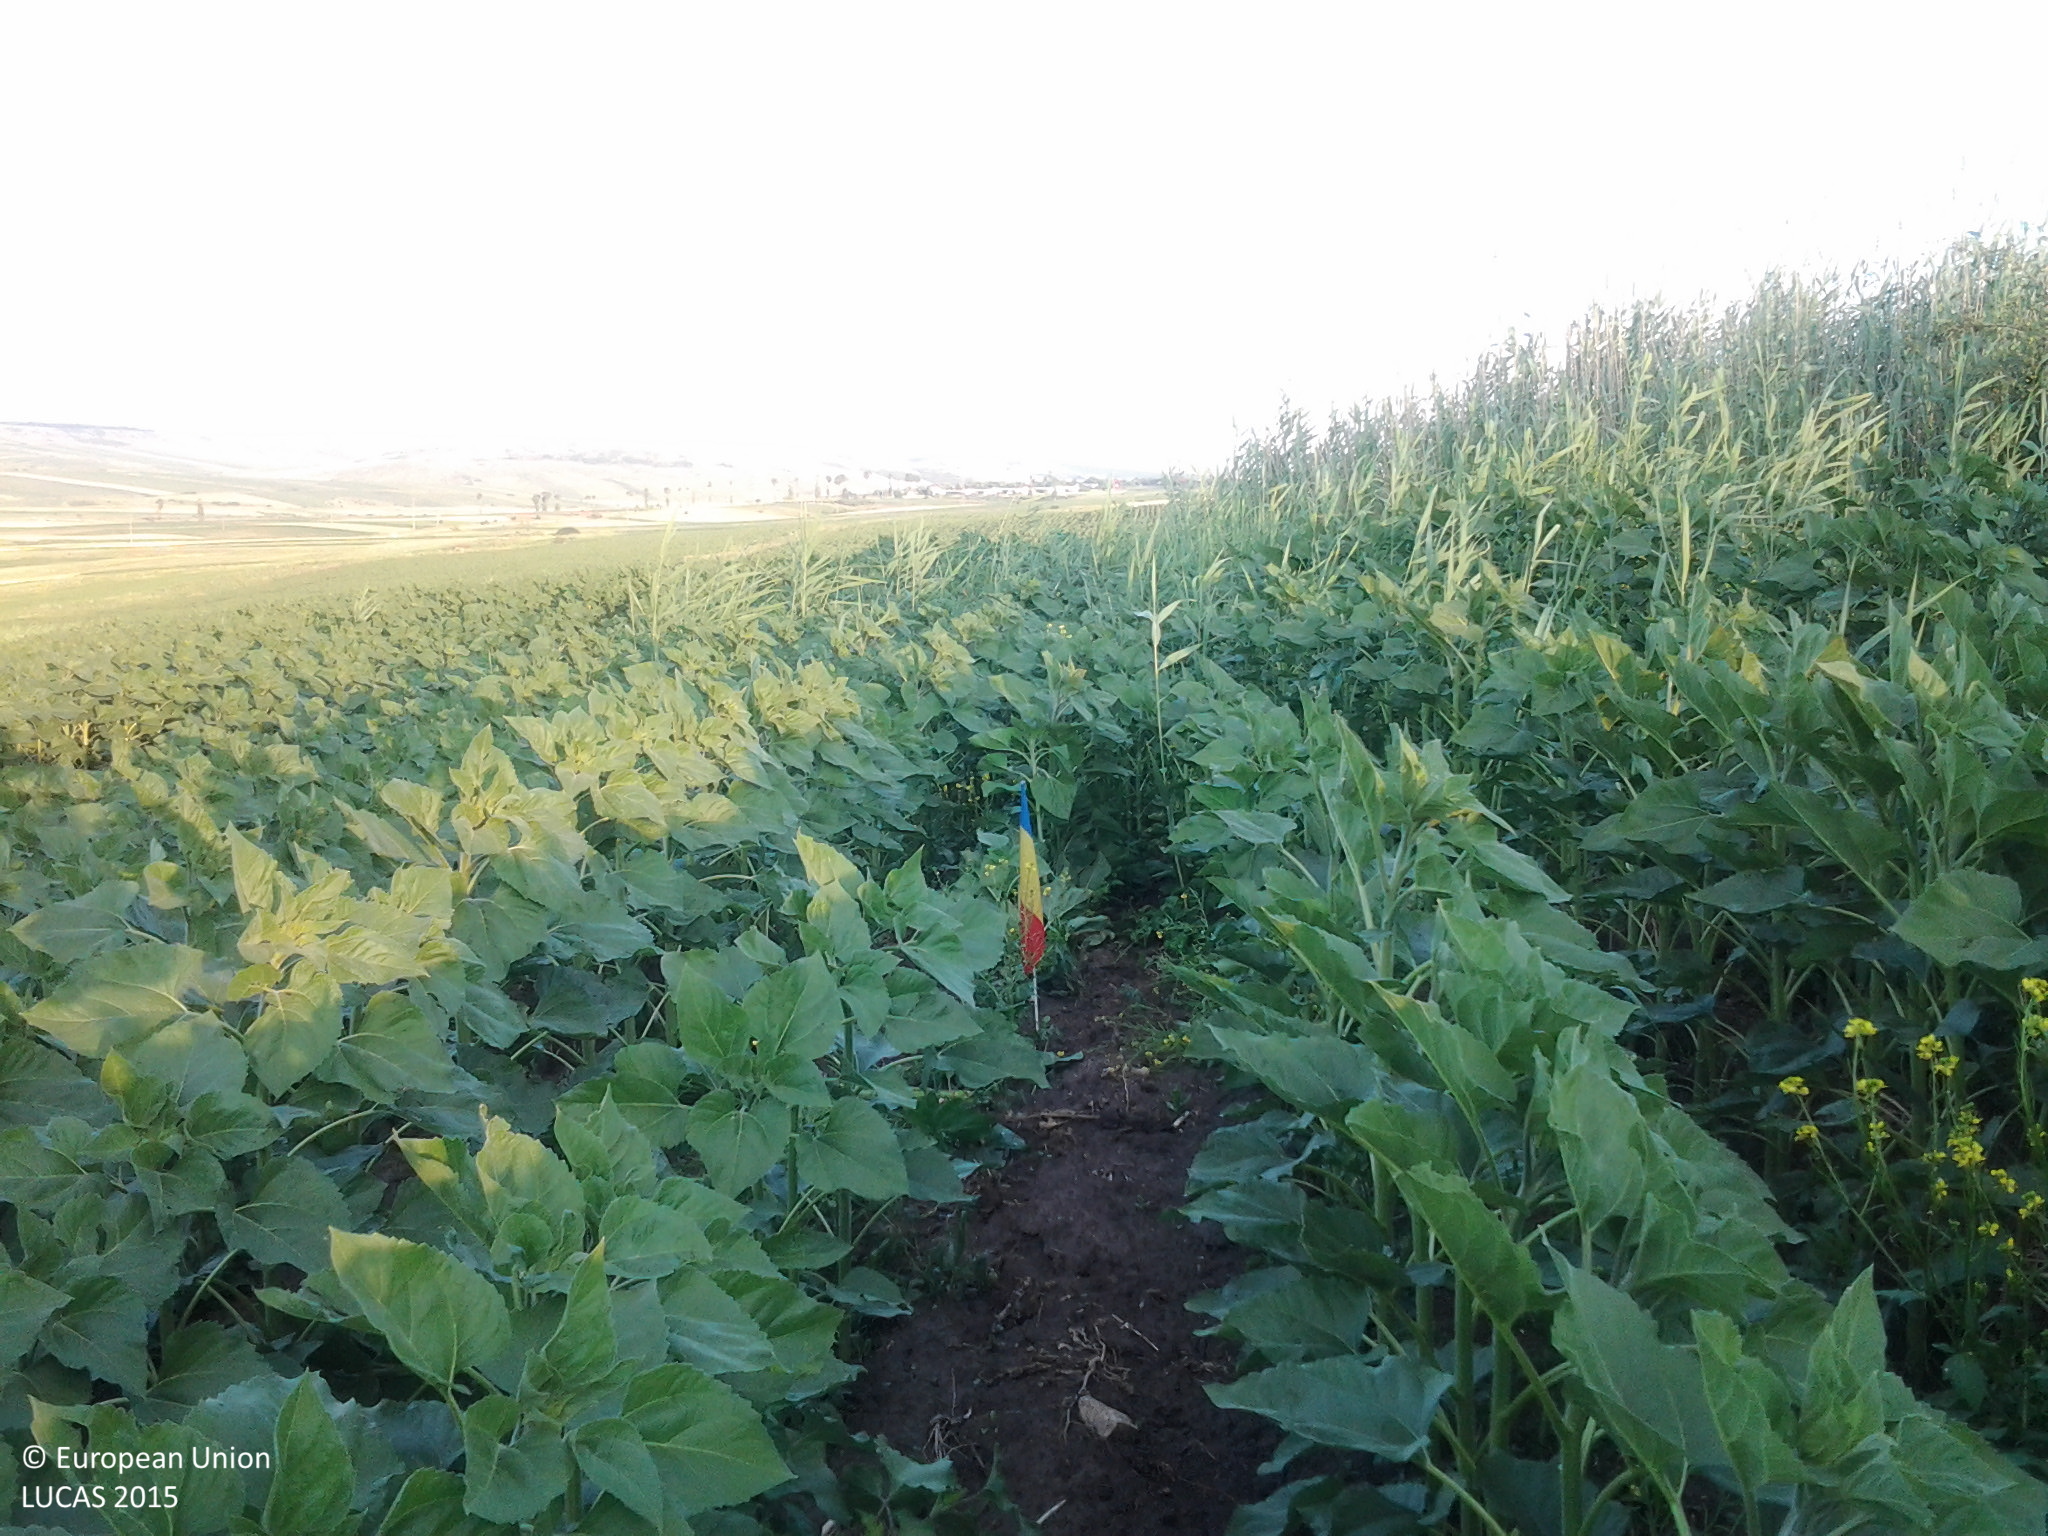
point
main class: Cropland
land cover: Sunflower
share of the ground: > 75 %
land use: Agriculture (excluding fallow land and kitchen gardens)
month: June
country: RO
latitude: 46.9083
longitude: 27.4556
